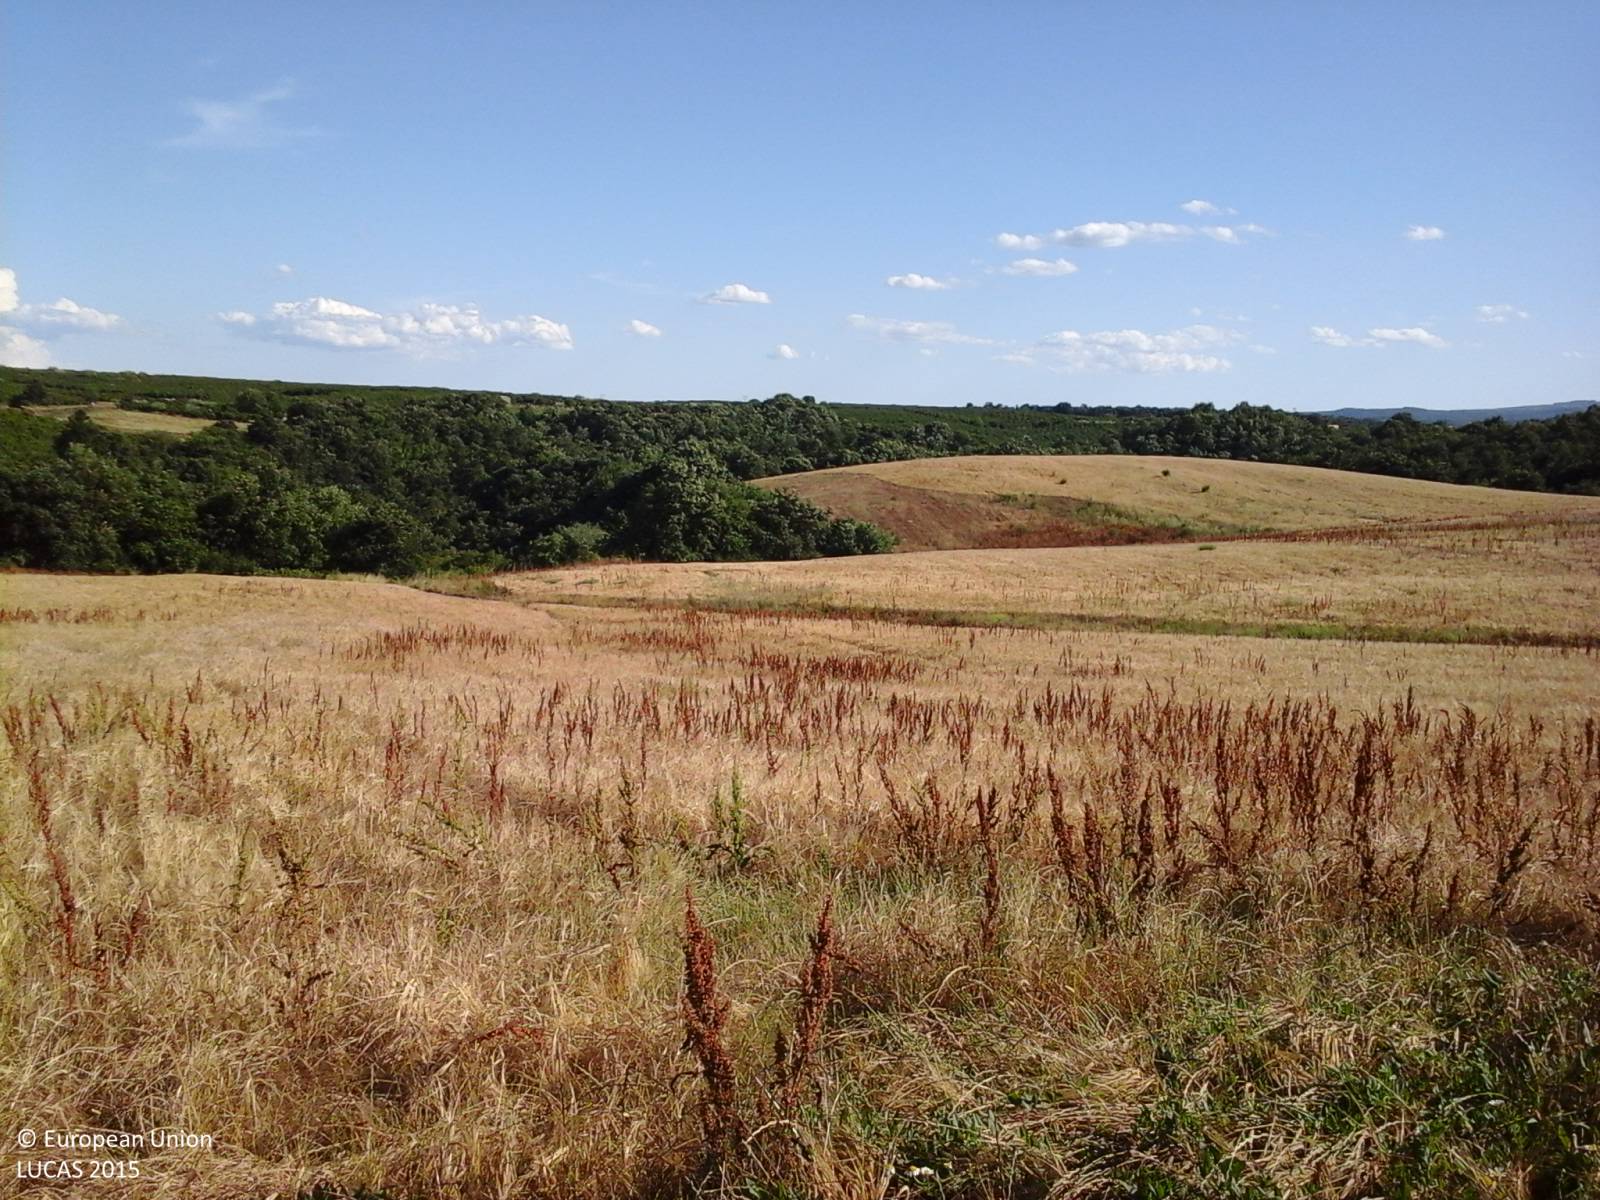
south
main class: Cropland
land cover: Barley
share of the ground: > 75 %
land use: Agriculture (excluding fallow land and kitchen gardens)
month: June
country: IT
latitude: 42.4469
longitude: 12.3144
